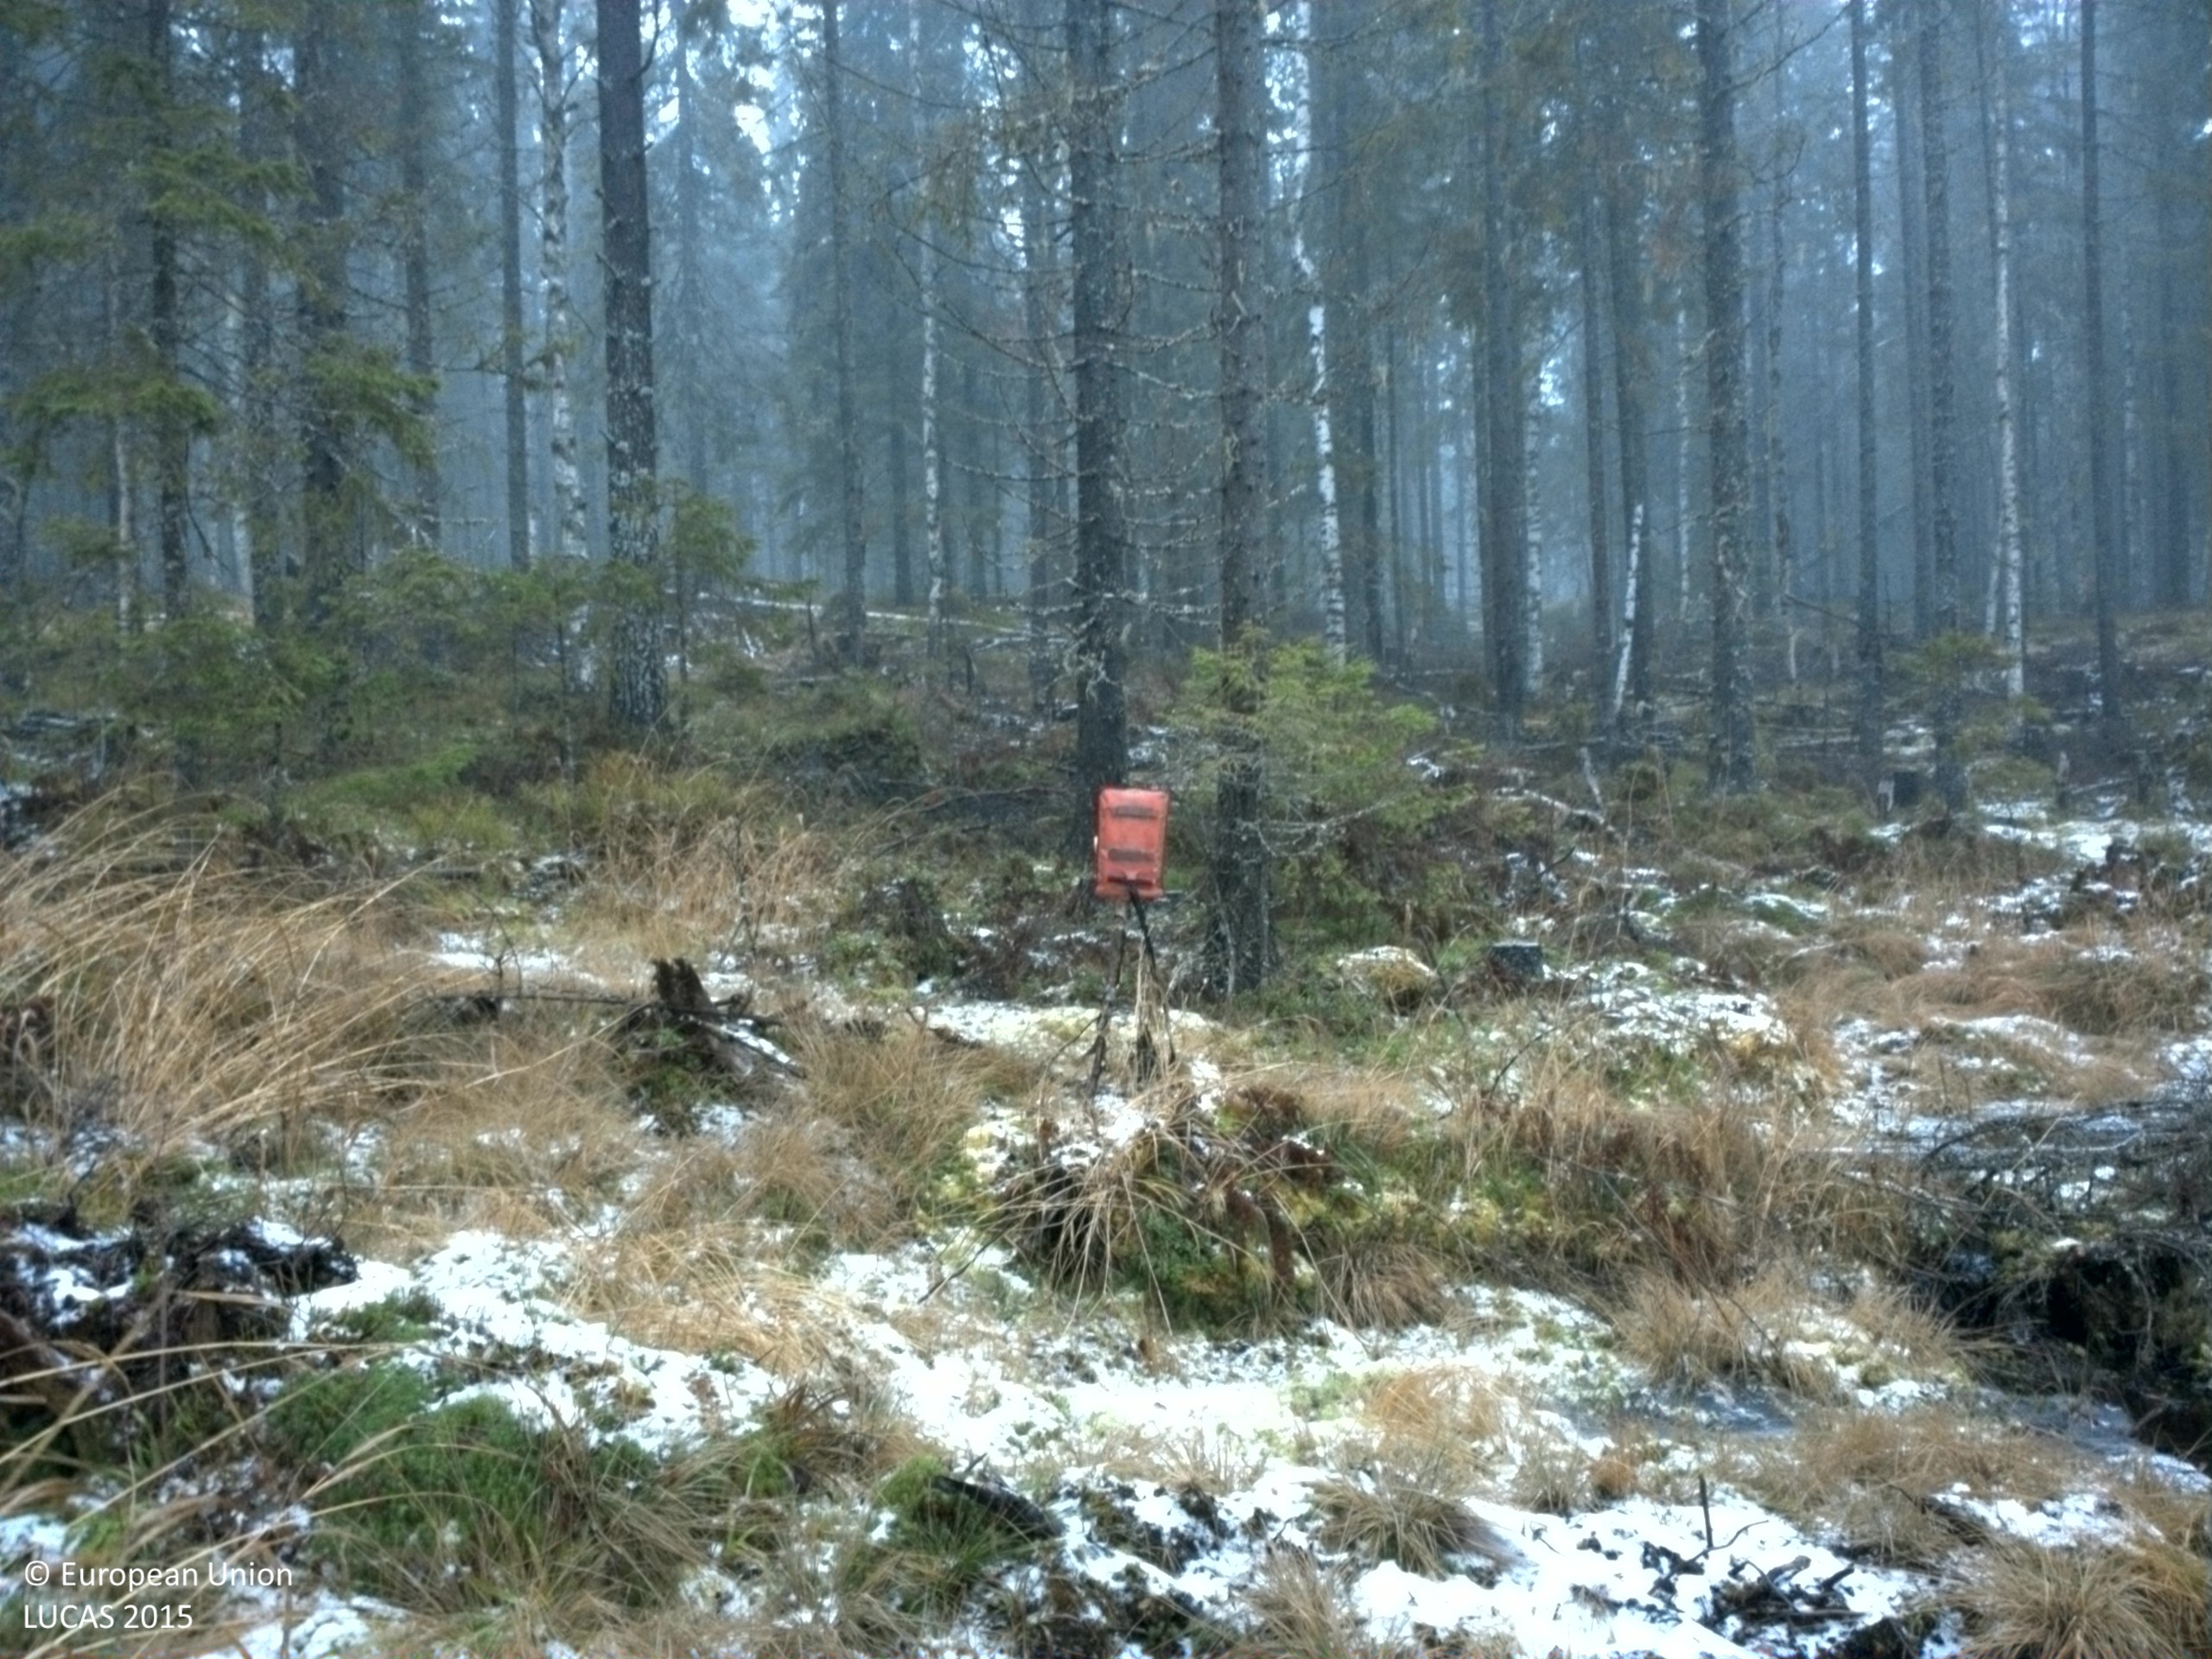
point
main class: Woodland
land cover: Spruce dominated coniferous woodland
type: boreal forest
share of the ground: 50 - 75 %
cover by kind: coniferous forest trees 45 %, shrubs 25 %, lichens and mosses 15 %, broadleaved forest trees 5 %, herbaceous plants 5 %
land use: Forestry
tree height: > 5 m
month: November
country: SE
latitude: 61.6264
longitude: 15.9630
